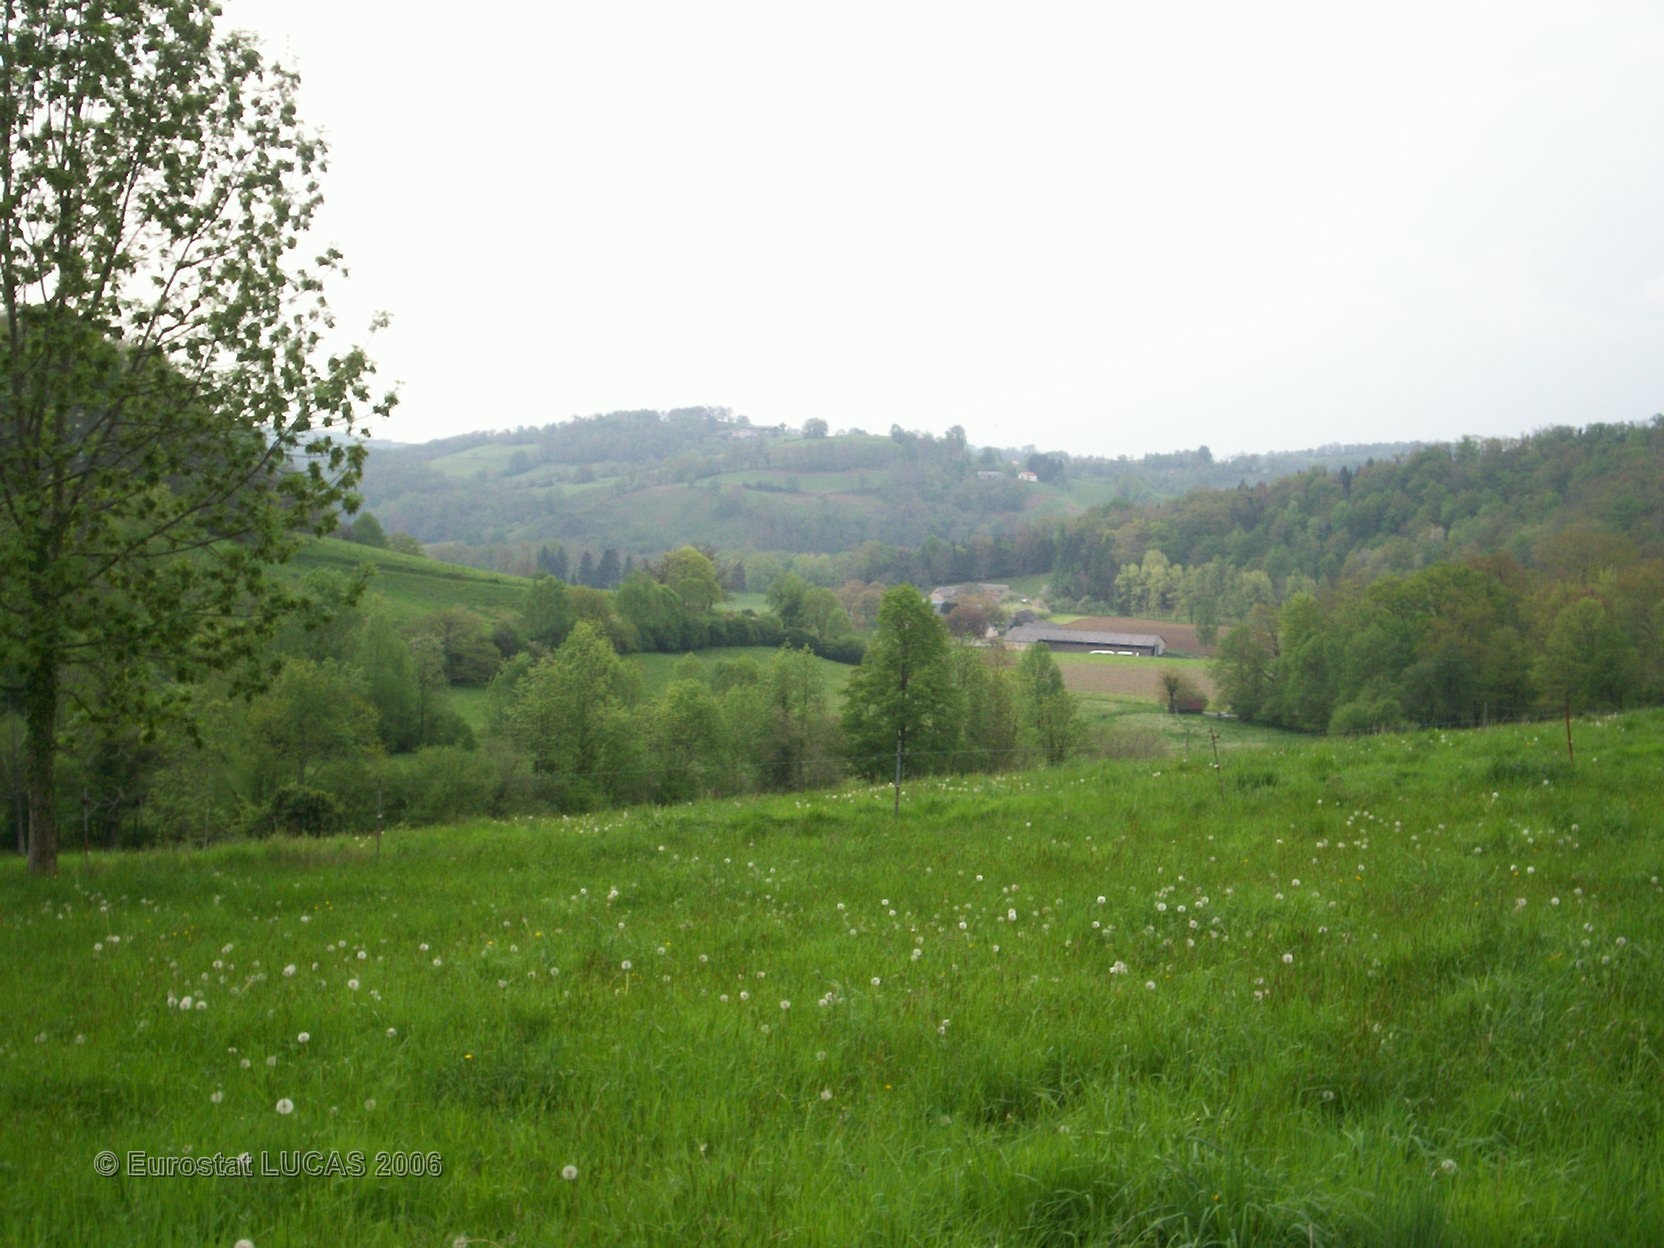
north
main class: Grassland
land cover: Grassland without tree/shrub cover
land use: Agriculture (excluding fallow land and kitchen gardens)
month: April
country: FR
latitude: 43.0920
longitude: -0.1140
